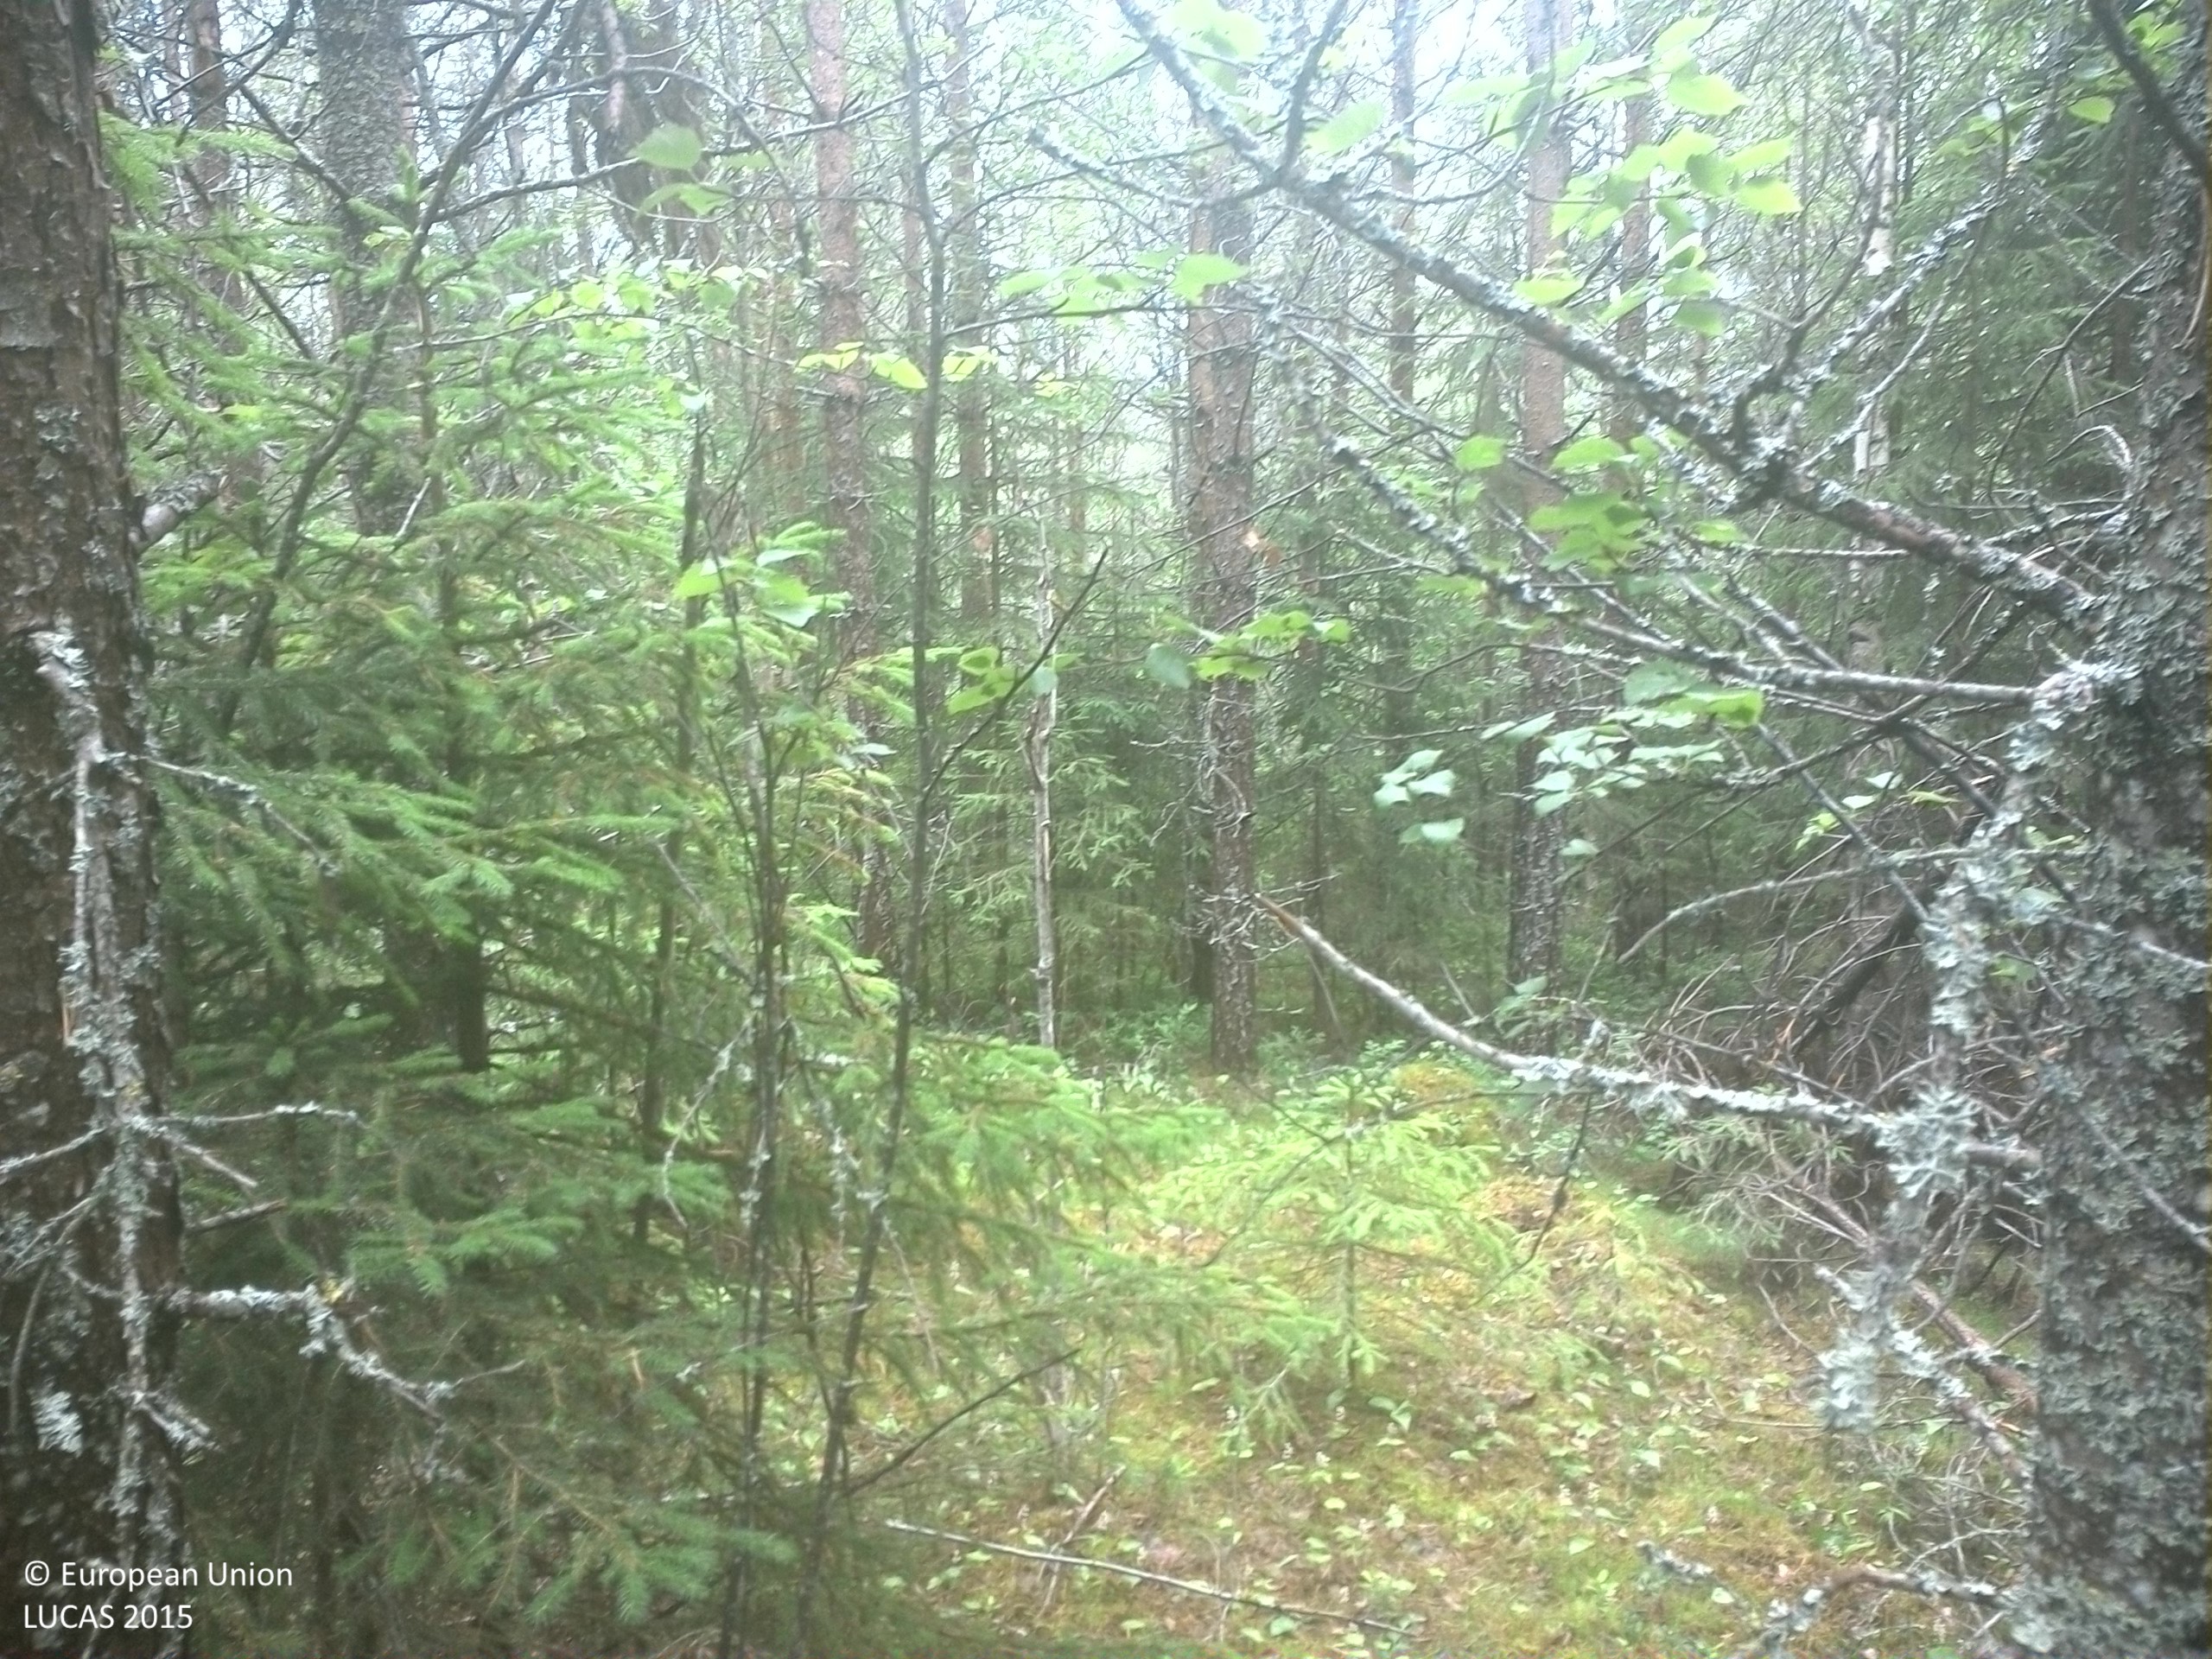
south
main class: Woodland
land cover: Pine dominated mixed woodland
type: exotic forest
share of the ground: > 75 %
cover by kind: coniferous forest trees 60 %, broadleaved forest trees 20 %, shrubs 20 %
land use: Forestry
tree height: > 5 m
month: July
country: SE
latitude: 63.5686
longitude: 18.5334
